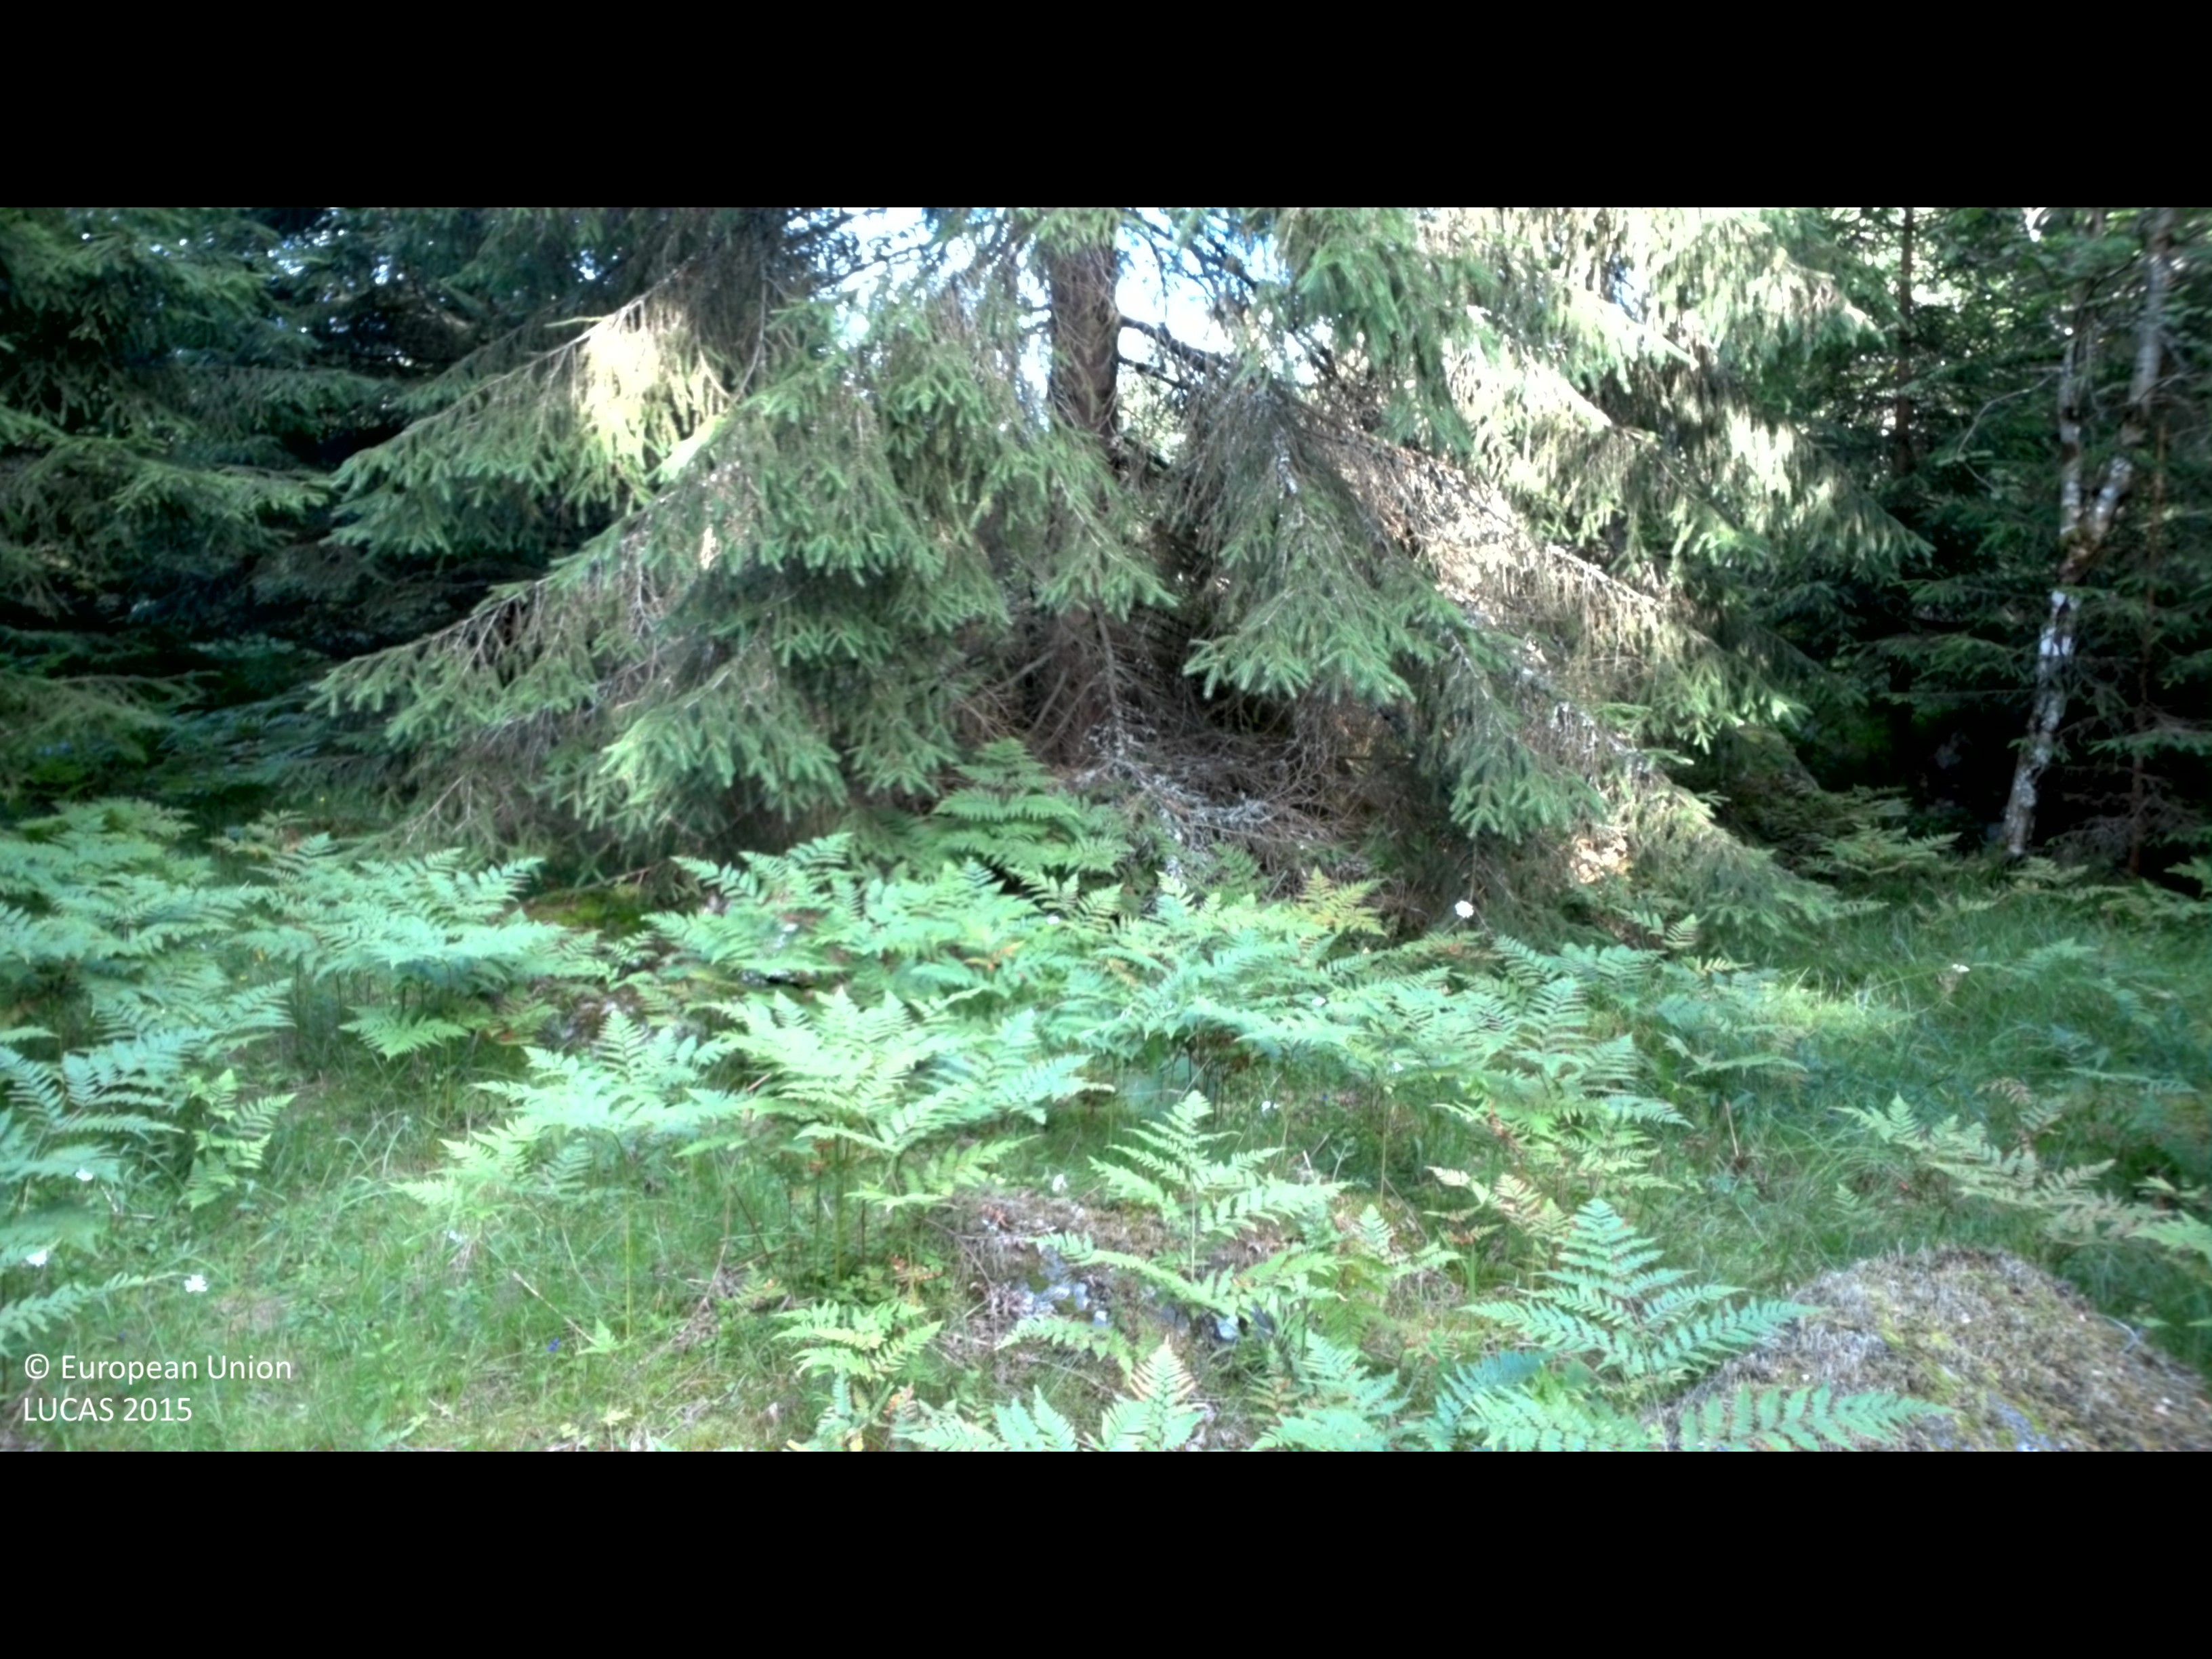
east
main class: Grassland
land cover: Grassland with sparse tree/shrub cover
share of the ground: > 75 %
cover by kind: herbaceous plants 95 %, coniferous forest trees 5 %
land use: Forestry
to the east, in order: Grassland with sparse tree/shrub cover; Fences; Spruce dominated mixed woodland; Spruce dominated coniferous woodland; Broadleaved woodland; Pine dominated mixed woodland
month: July
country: SE
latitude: 56.4254
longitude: 14.7160
